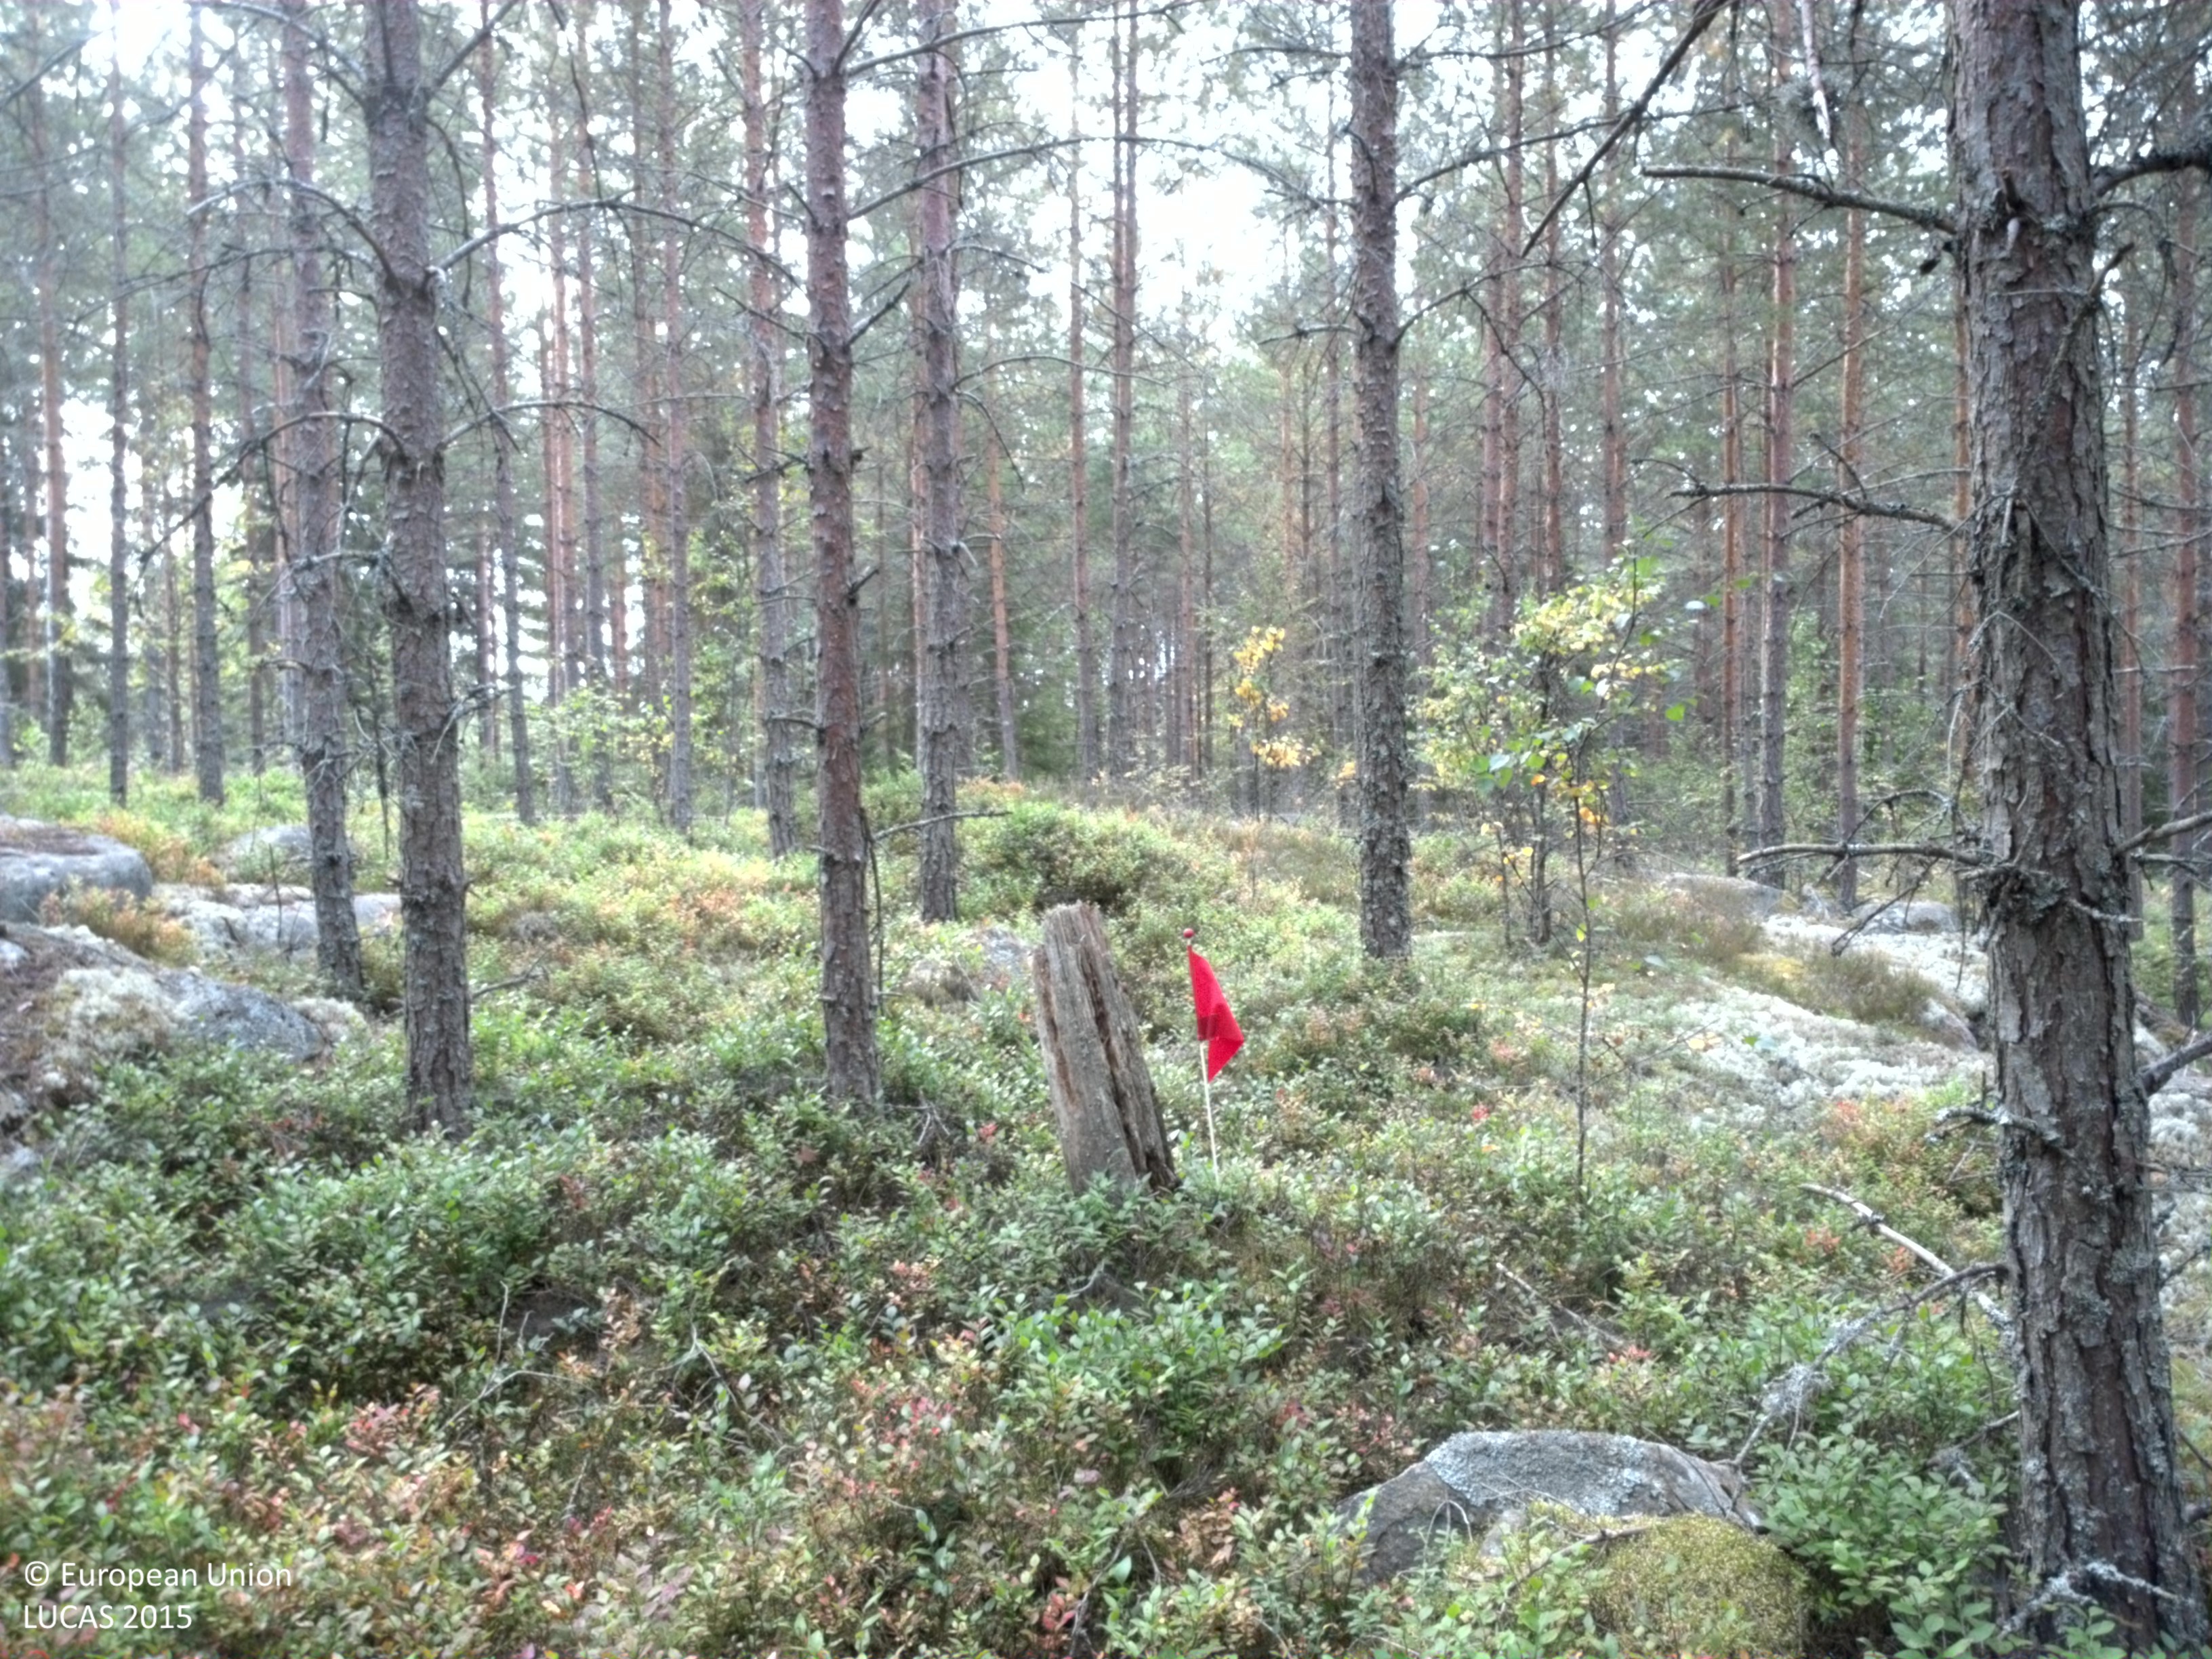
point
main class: Woodland
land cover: Pine dominated coniferous woodland
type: boreal forest
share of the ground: 50 - 75 %
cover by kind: coniferous forest trees 70 %, shrubs 20 %, lichens and mosses 10 %
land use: Forestry
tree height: > 5 m
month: August
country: SE
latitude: 59.6331
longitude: 13.4853
